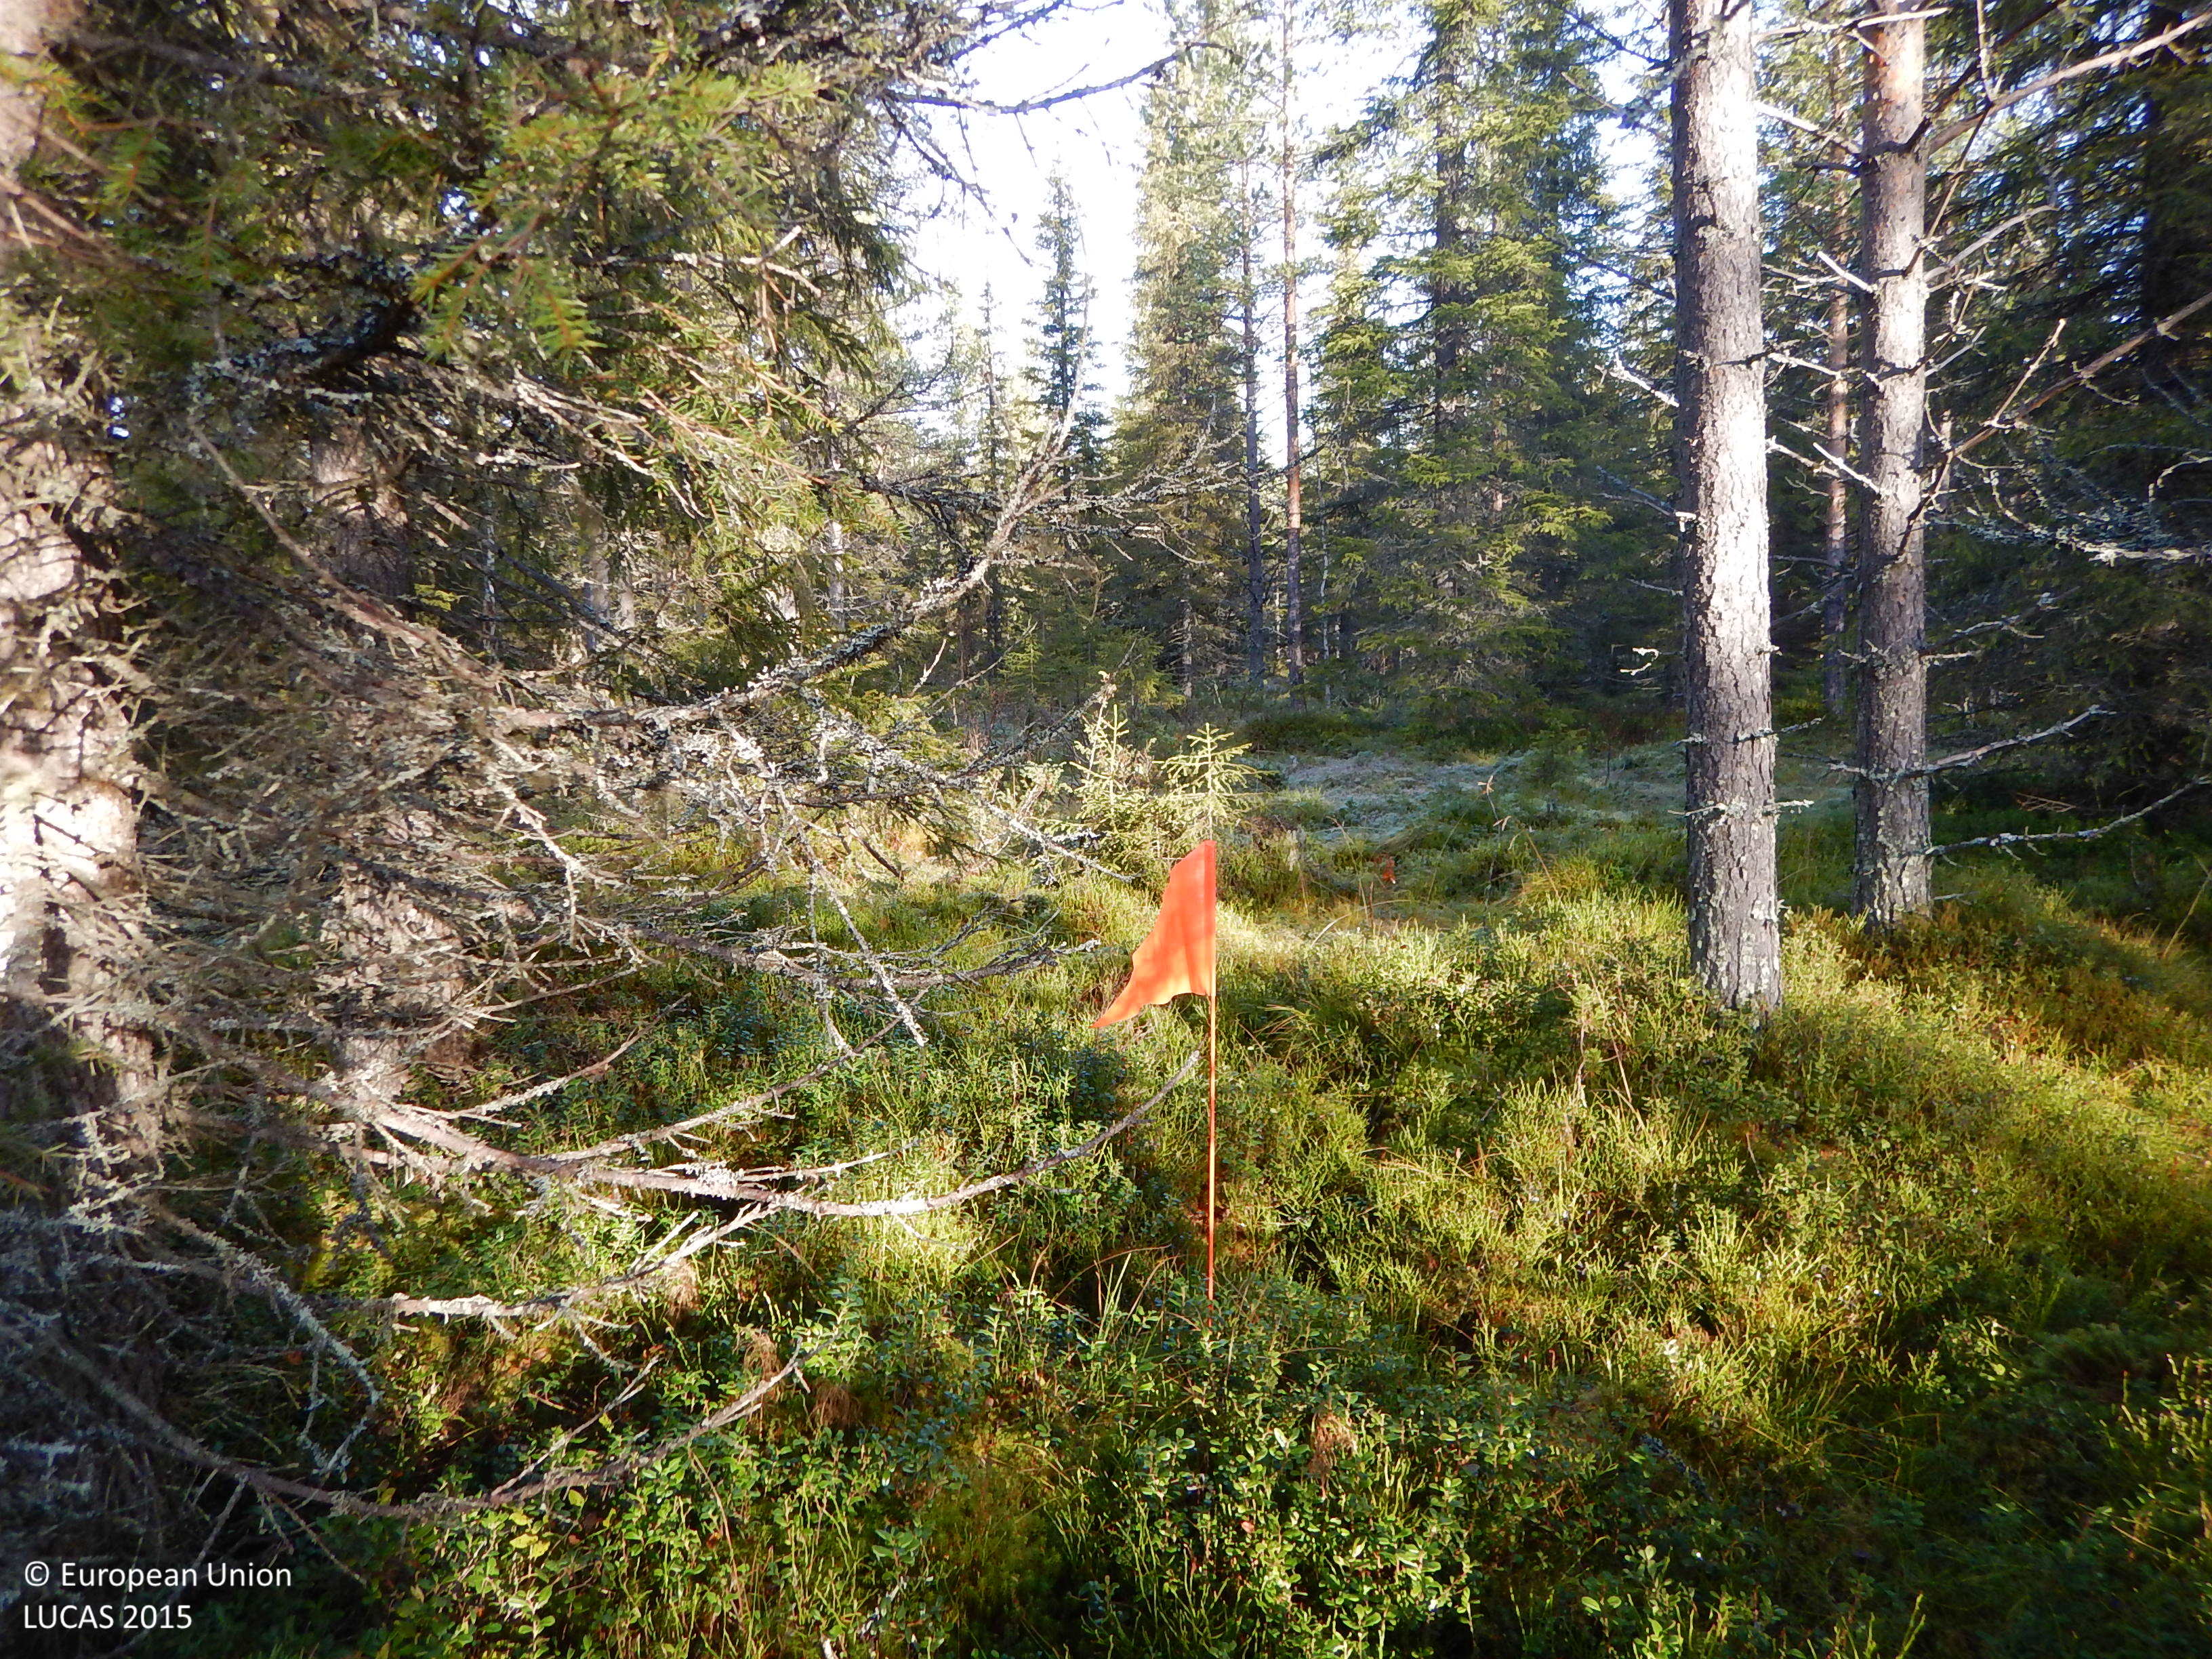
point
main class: Woodland
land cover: Other coniferous woodland
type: boreal forest
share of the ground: 50 - 75 %
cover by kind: coniferous forest trees 60 %, lichens and mosses 20 %, shrubs 15 %, herbaceous plants 5 %
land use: Forestry
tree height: > 5 m
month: October
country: SE
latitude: 65.2963
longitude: 20.4121
